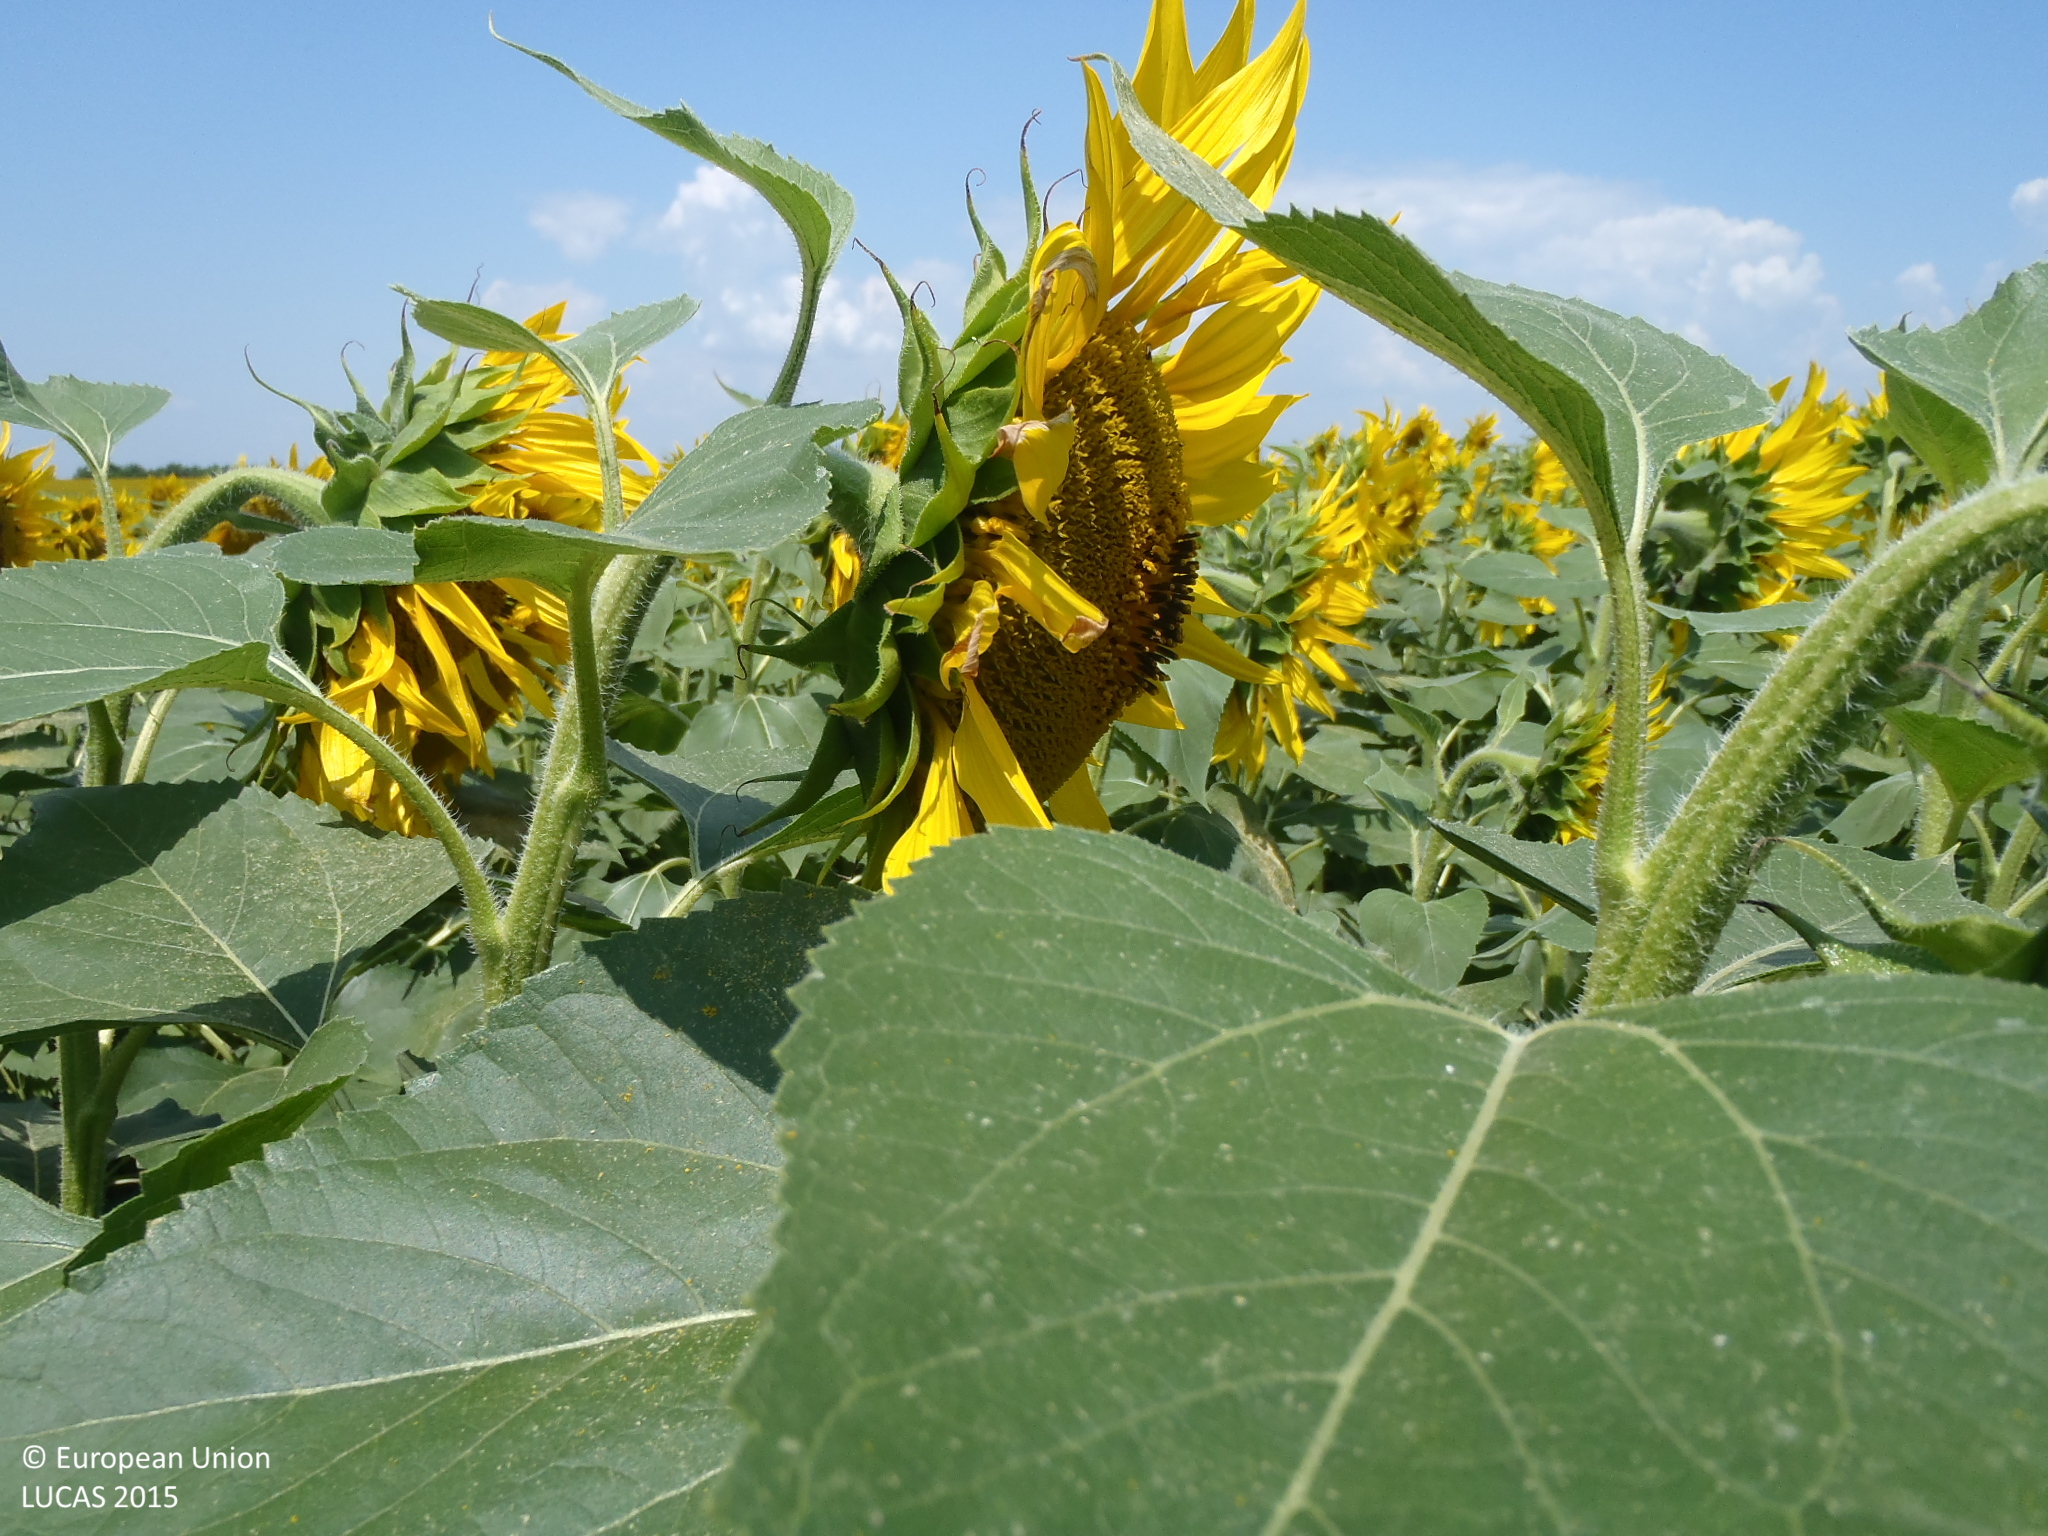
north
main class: Cropland
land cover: Sunflower
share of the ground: > 75 %
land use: Agriculture (excluding fallow land and kitchen gardens)
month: July
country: BG
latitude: 43.9450
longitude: 26.3403
